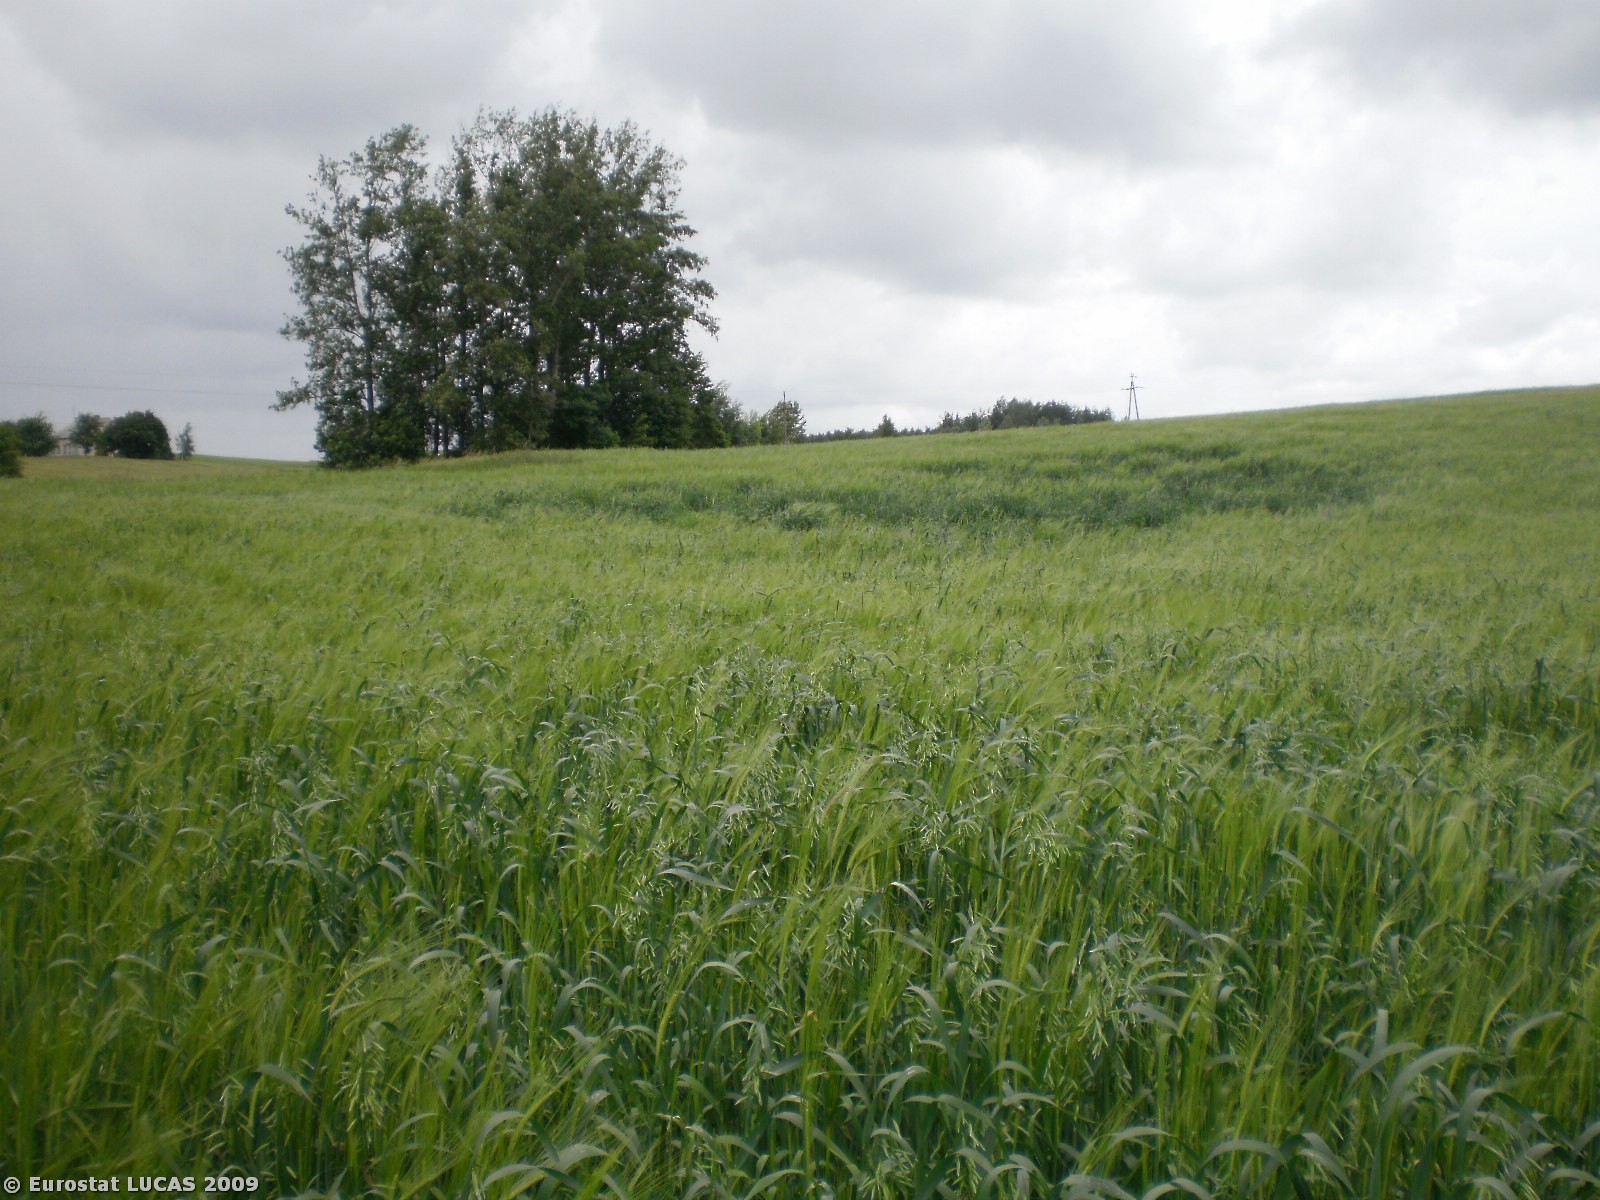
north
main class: Cropland
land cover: Mixed cereals for fodder
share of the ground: > 75 %
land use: Agriculture (excluding fallow land and kitchen gardens)
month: June
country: PL
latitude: 53.4383
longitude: 19.7995
